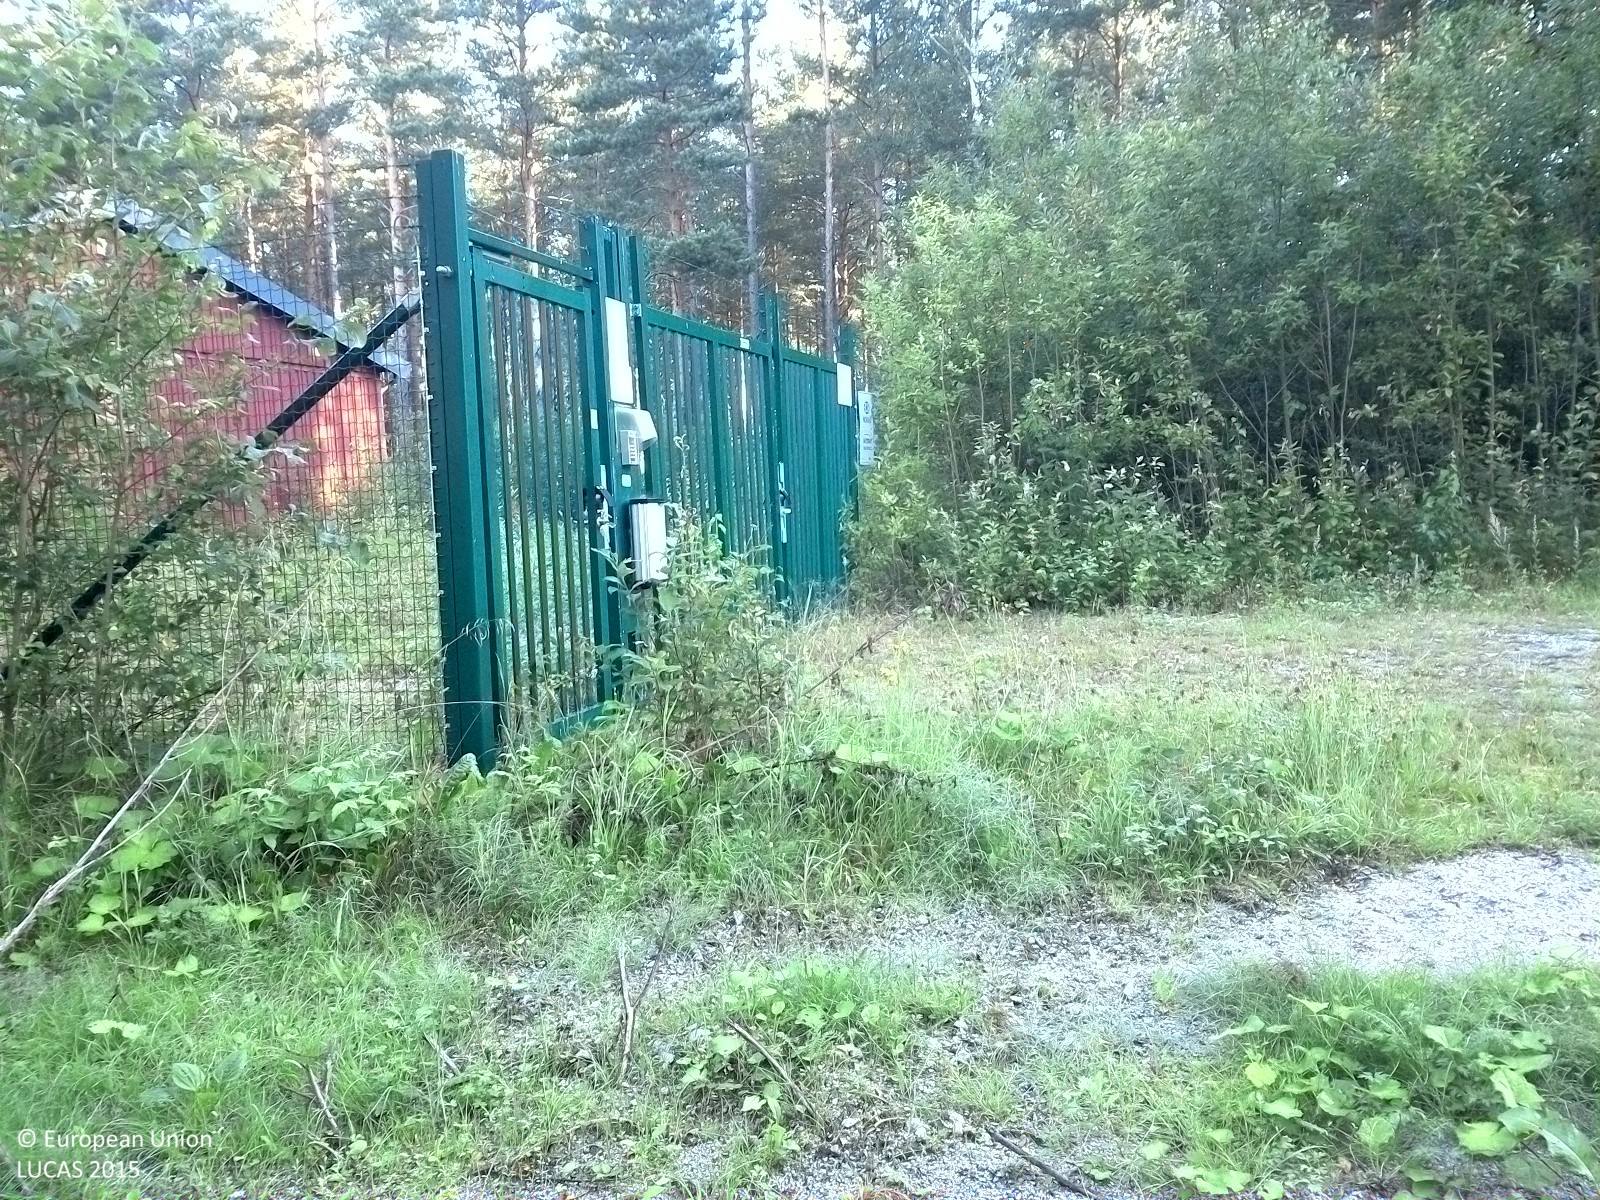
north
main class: Woodland
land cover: Other mixed woodland
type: hemiboreal forest and nemoral coniferous forest and mixed broadleaved-coniferous forest
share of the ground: 25 - 50 %
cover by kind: herbaceous plants 45 %, broadleaved forest trees 25 %, coniferous forest trees 20 %, lichens and mosses 10 %
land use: Forestry
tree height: > 5 m
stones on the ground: < 10 %
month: August
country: SE
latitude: 59.2755
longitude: 15.1331
